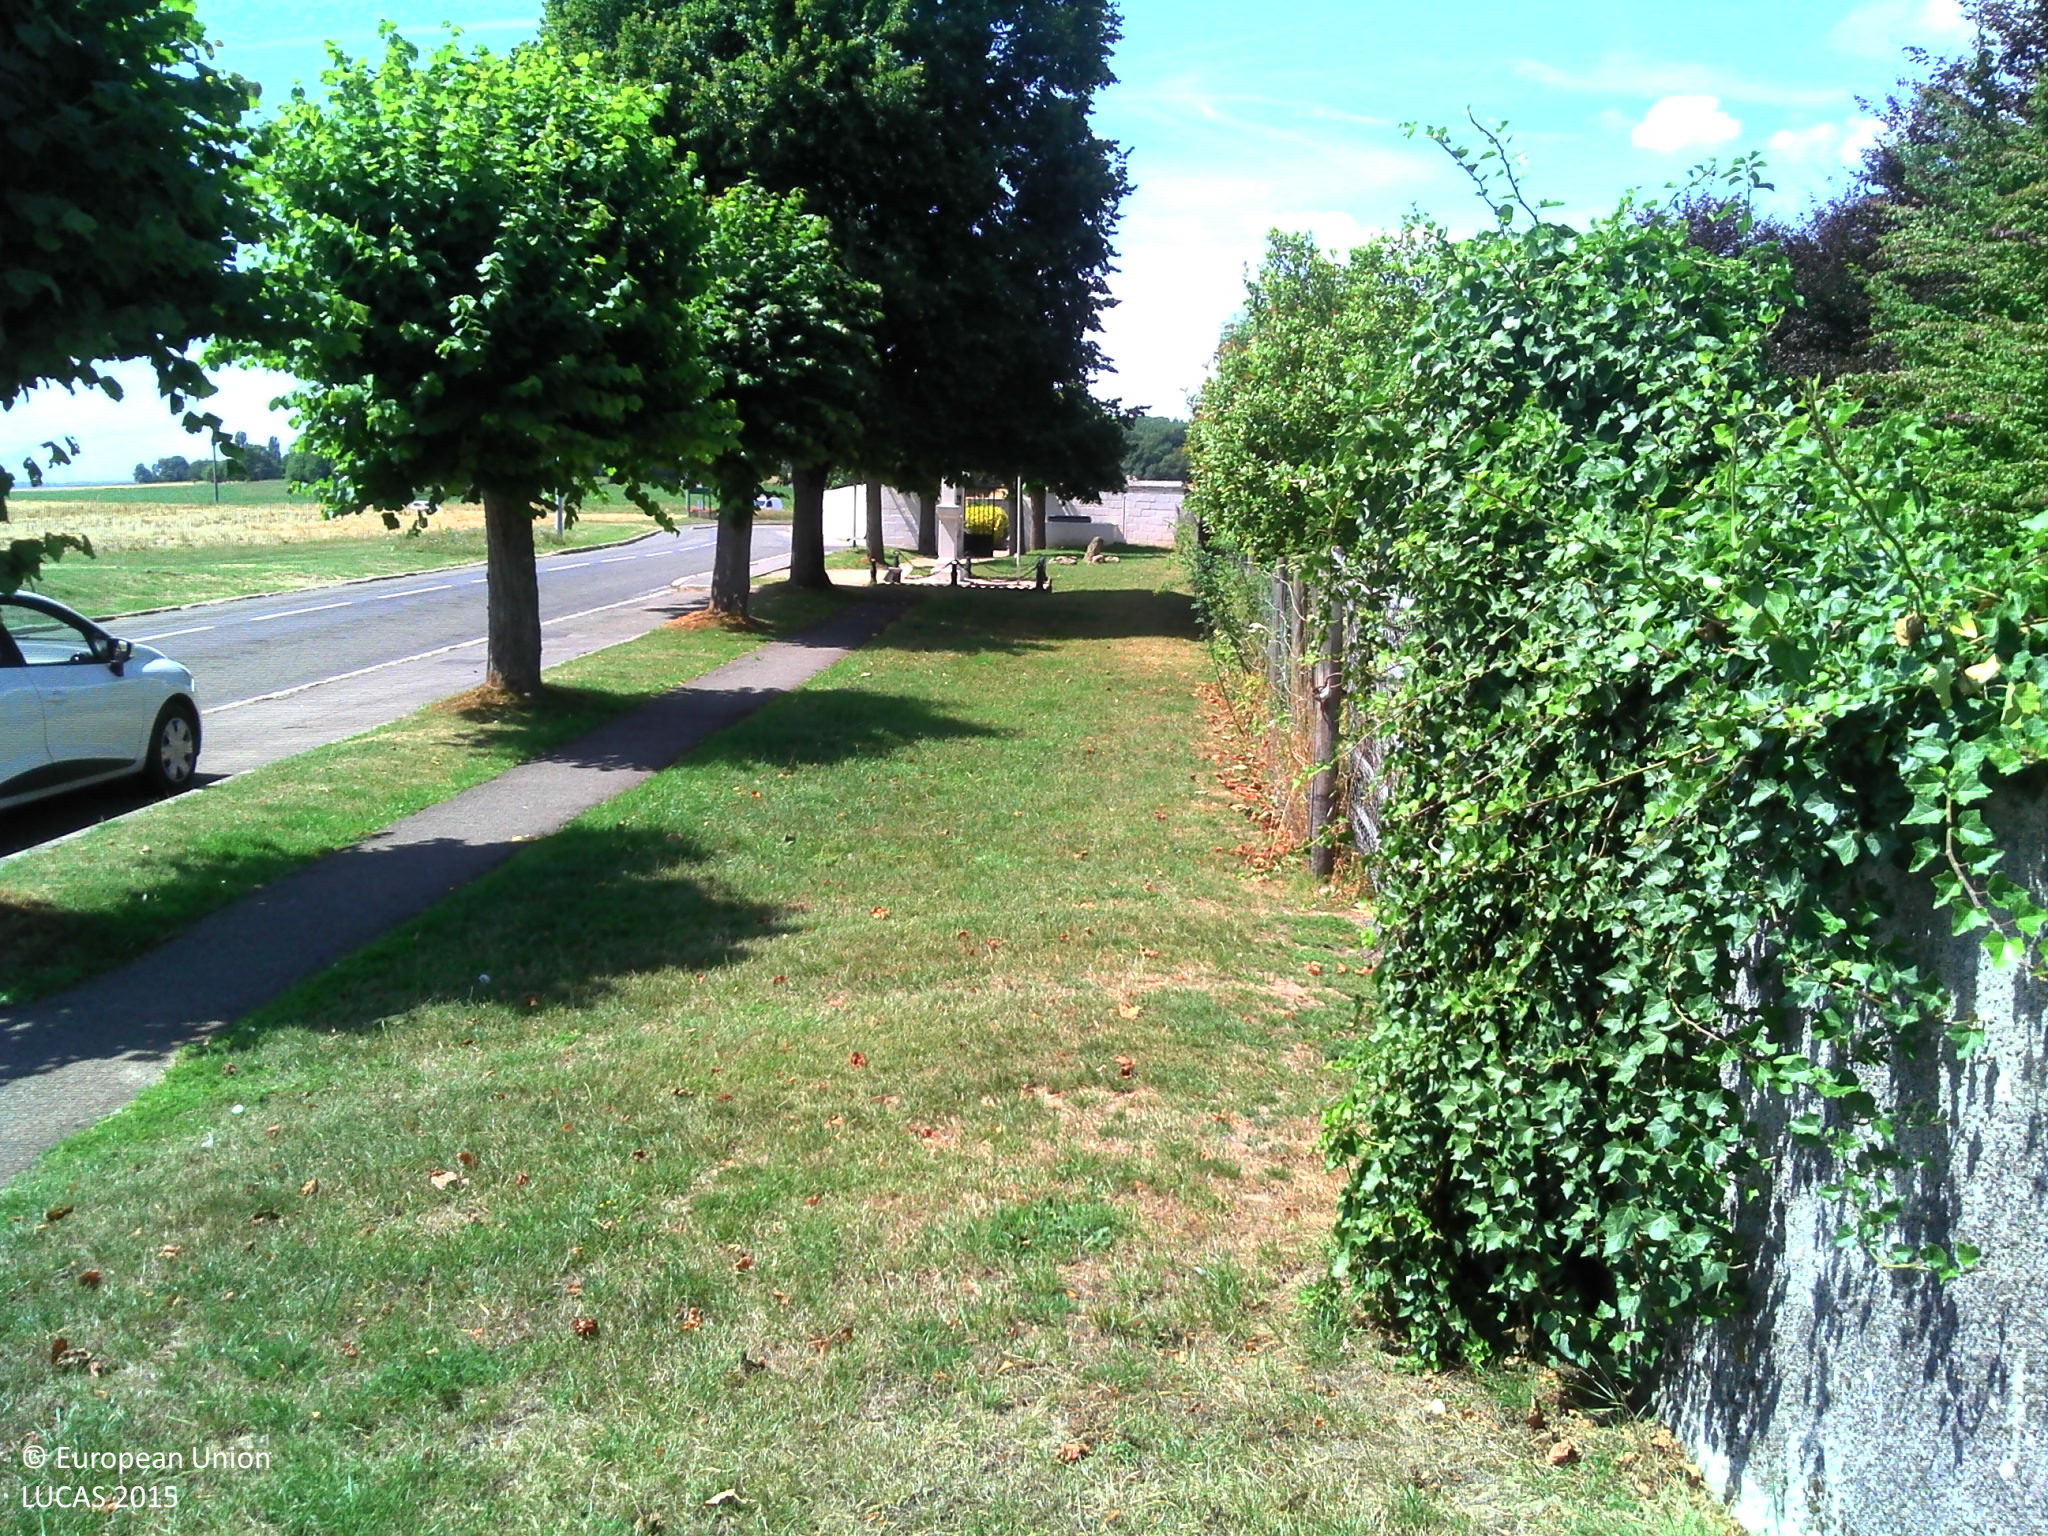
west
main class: Woodland
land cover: Broadleaved woodland
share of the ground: > 75 %
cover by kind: broadleaved forest trees 85 %, herbaceous plants 15 %
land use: Residential
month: July
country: FR
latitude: 49.0683
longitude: 2.4738
